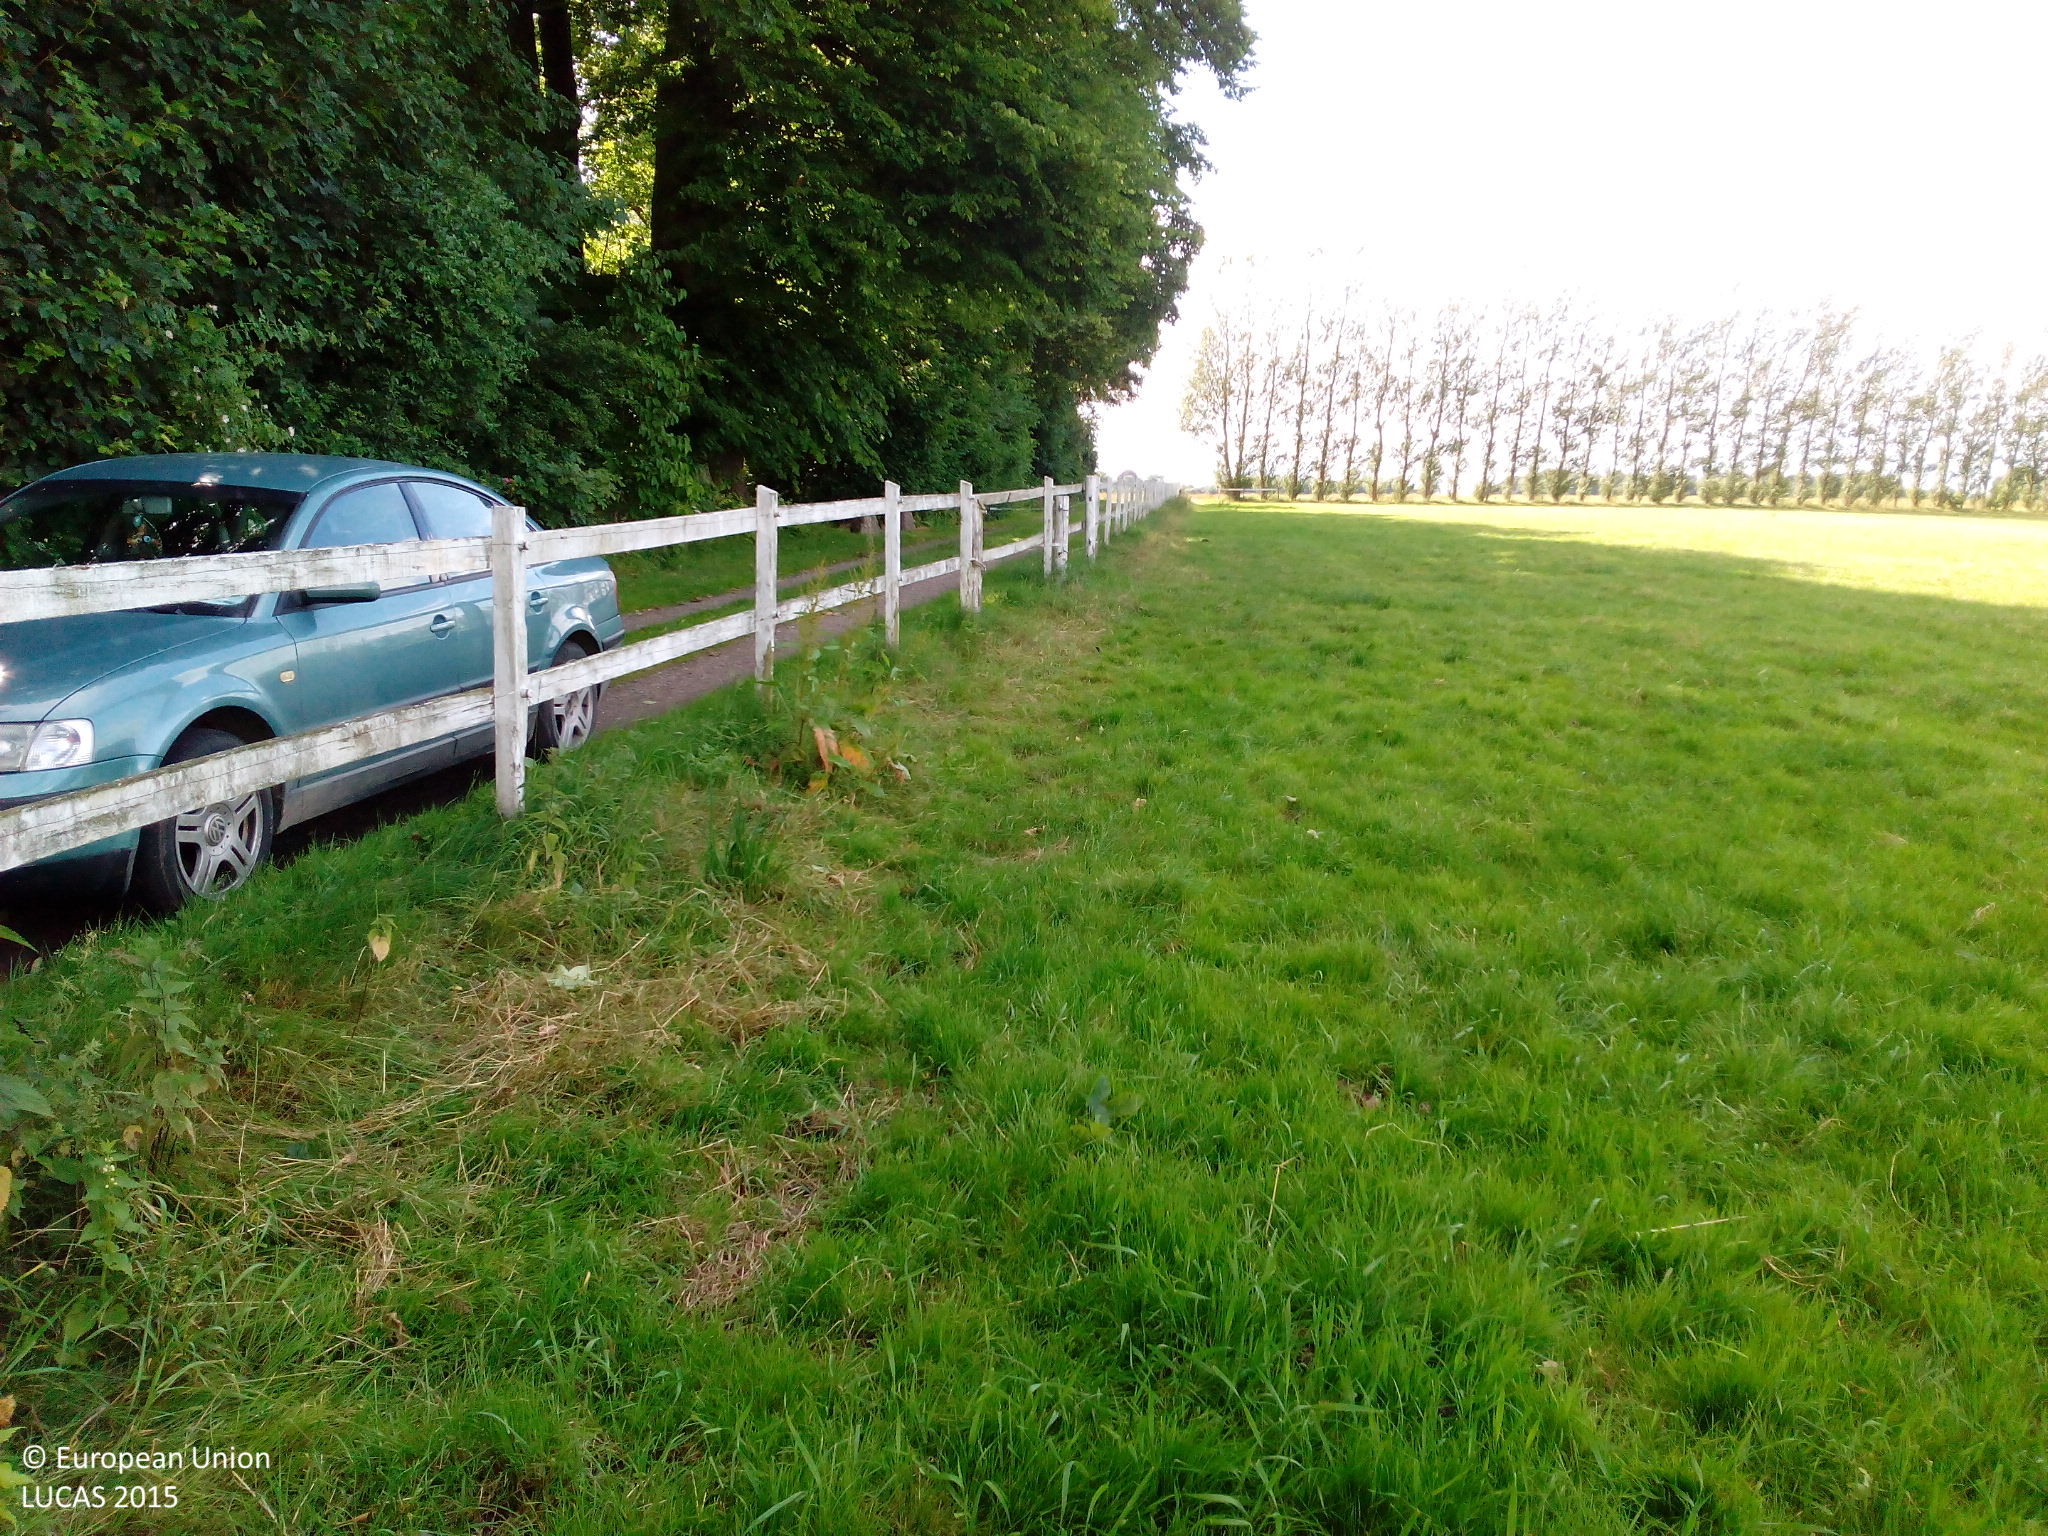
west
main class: Grassland
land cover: Grassland without tree/shrub cover
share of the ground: > 75 %
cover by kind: herbaceous plants 100 %
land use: Agriculture (excluding fallow land and kitchen gardens)
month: July
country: DK
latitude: 55.2907
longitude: 12.0299
